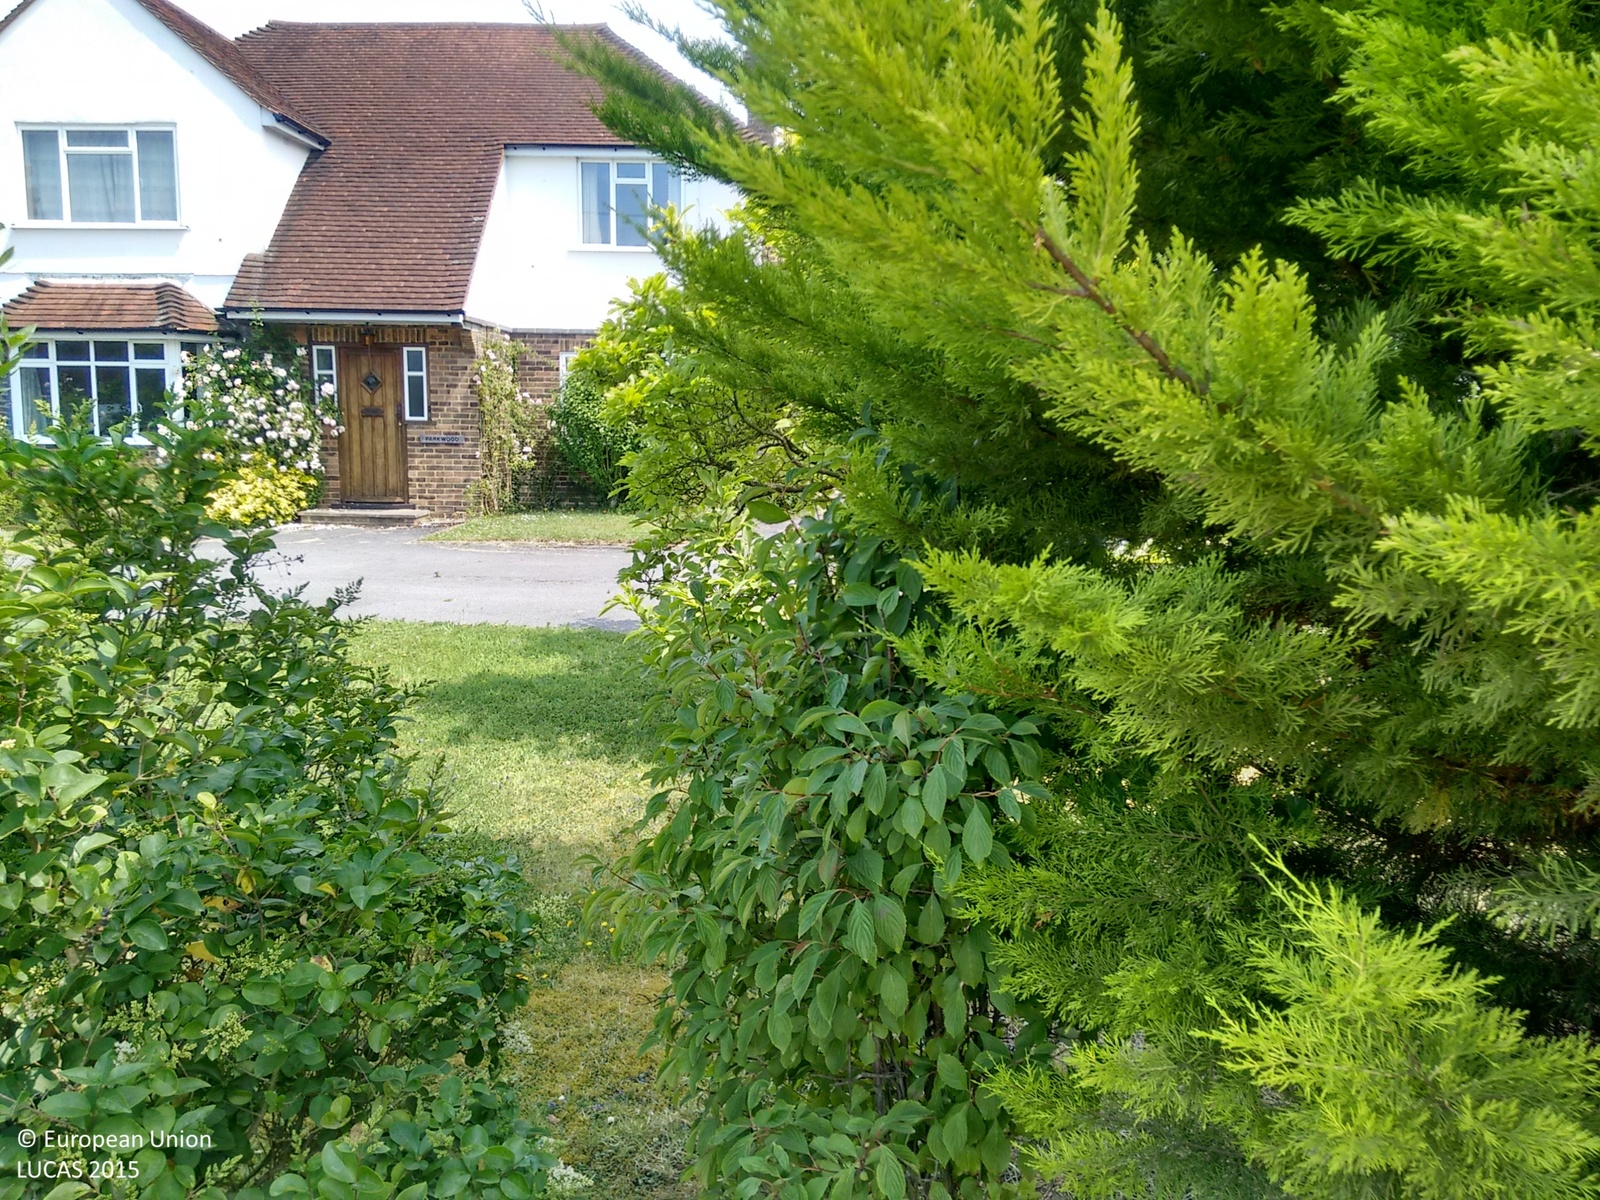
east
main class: Grassland
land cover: Grassland with sparse tree/shrub cover
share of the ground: > 75 %
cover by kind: herbaceous plants 85 %, shrubs 10 %, broadleaved forest trees 5 %
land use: Residential
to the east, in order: Grassland with sparse tree/shrub cover; Artificial constructions in urban areas
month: July
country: GB
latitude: 50.9466
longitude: -0.1256
